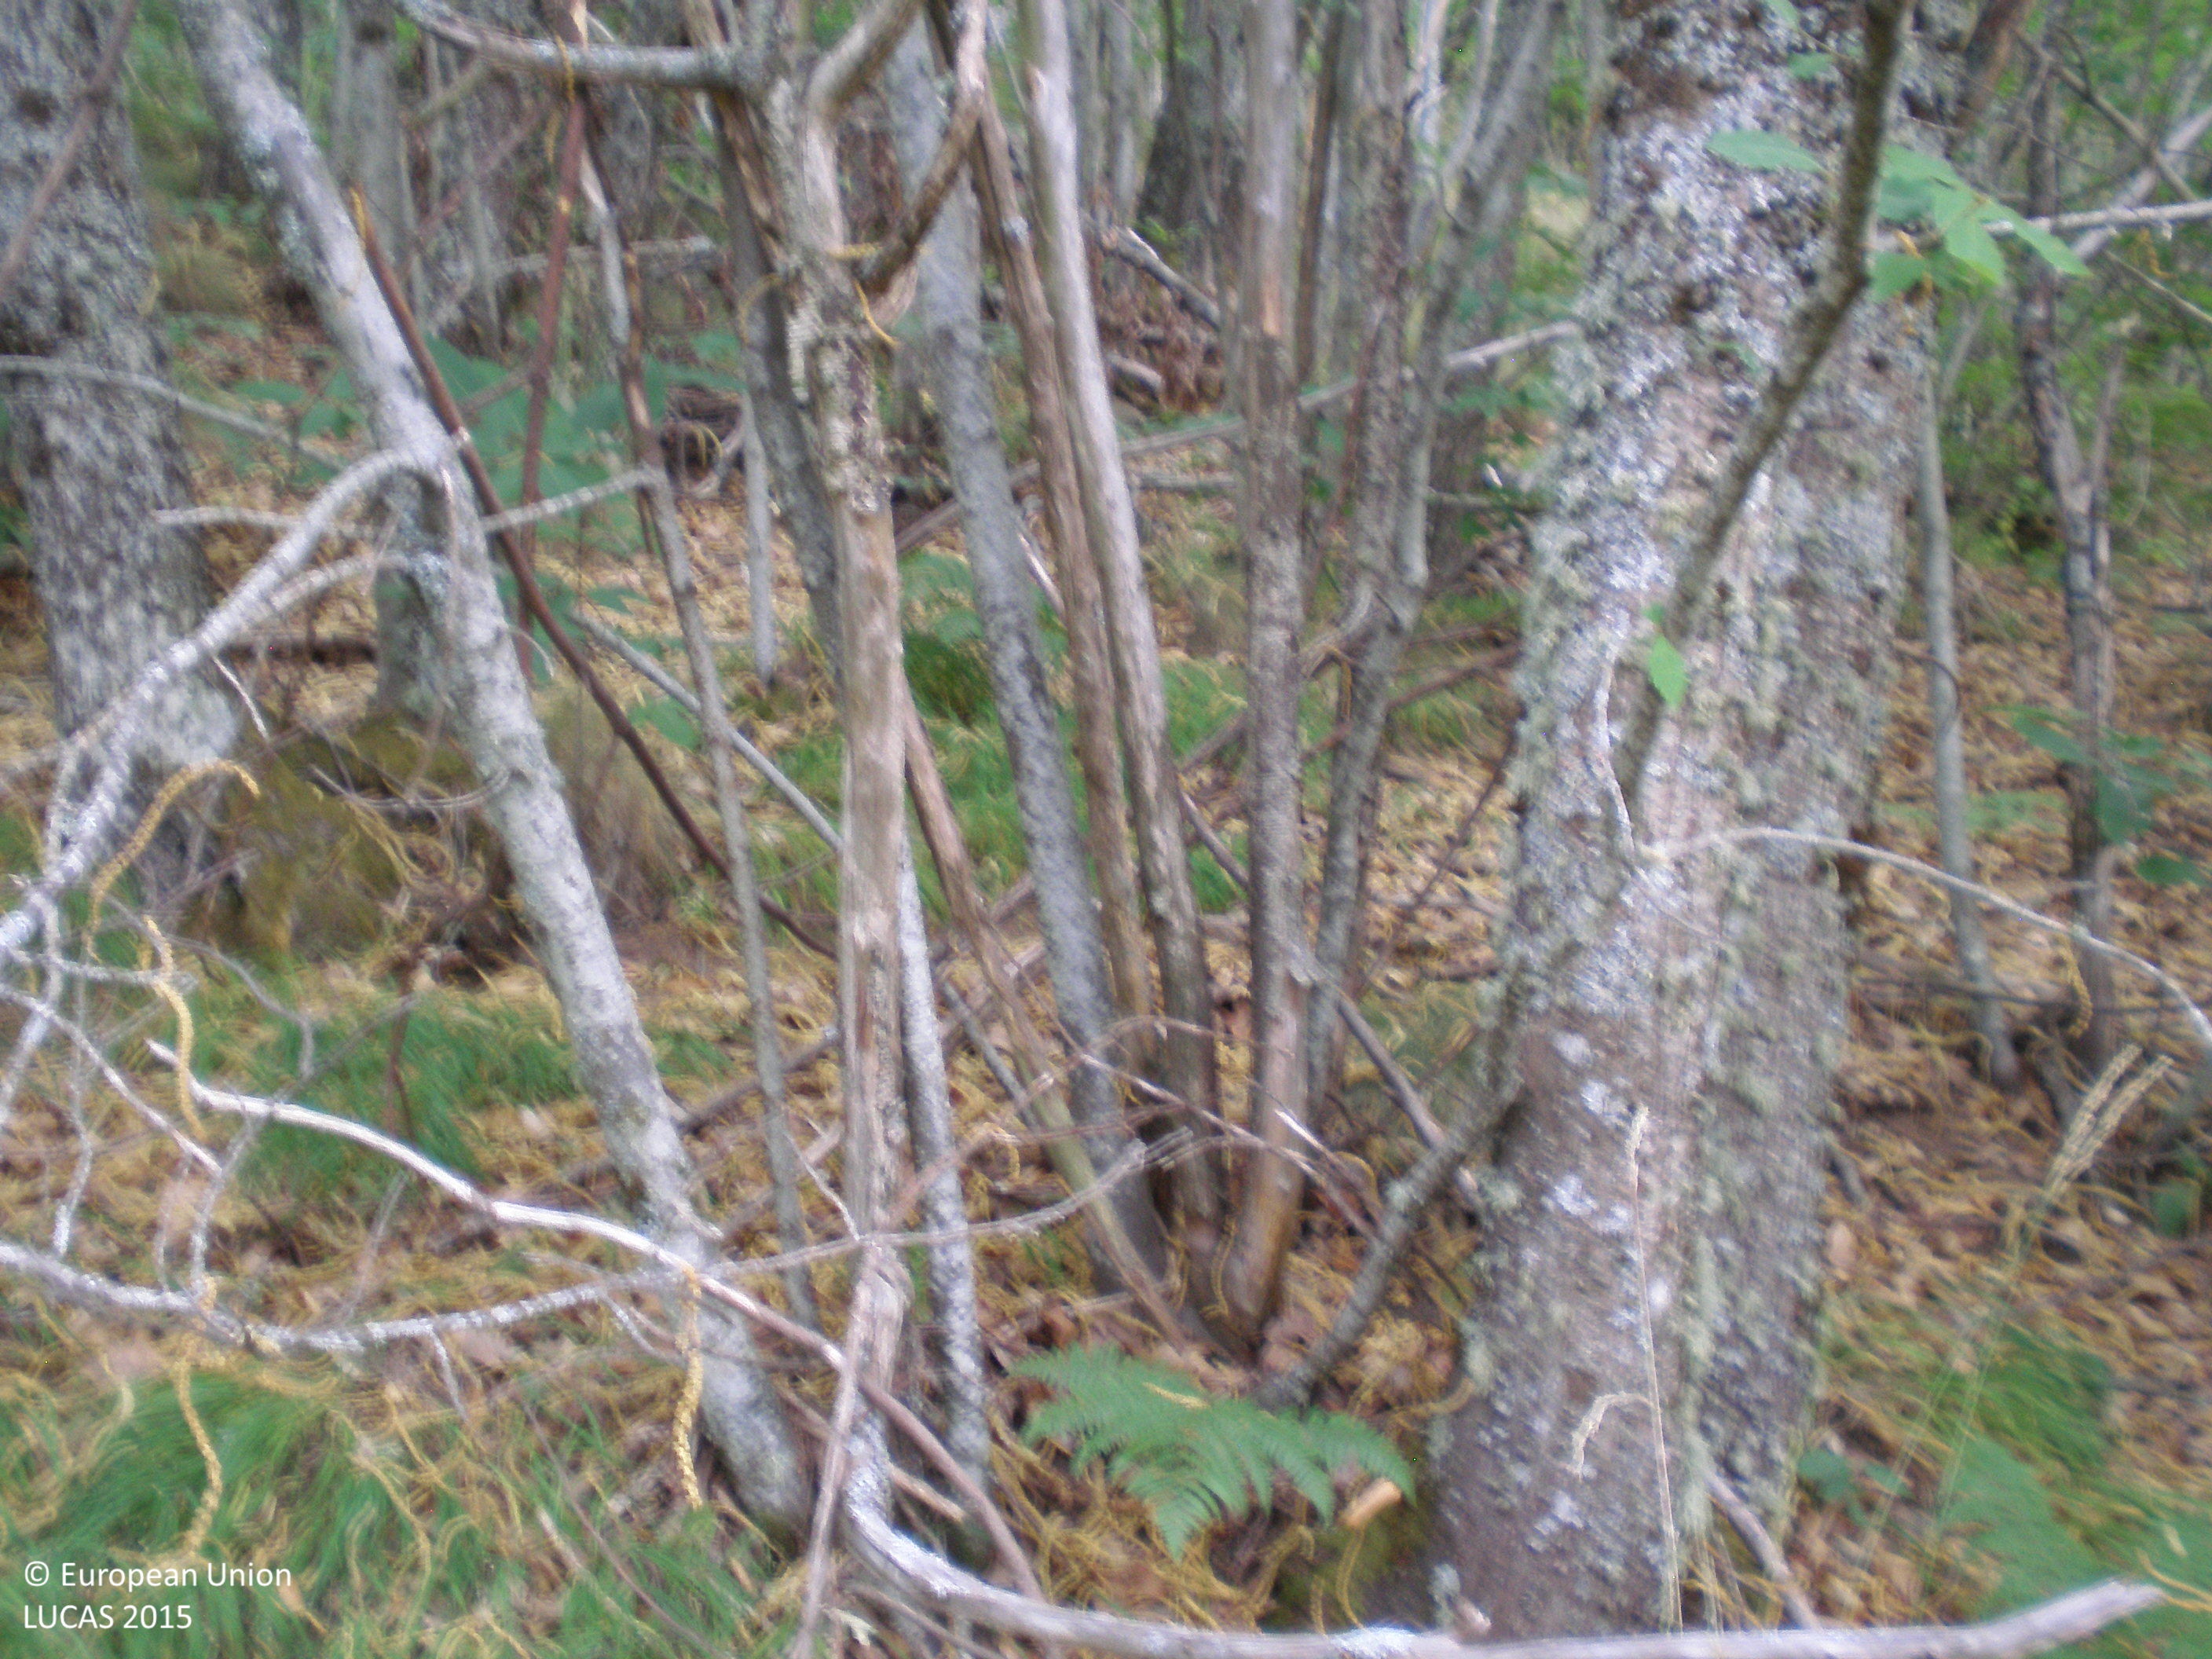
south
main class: Woodland
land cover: Broadleaved woodland
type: thermophilous deciduous forest
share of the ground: > 75 %
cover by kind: broadleaved forest trees 100 %
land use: Forestry
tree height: > 5 m
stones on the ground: < 10 %
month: July
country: ES
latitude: 40.3802
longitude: -5.7719
